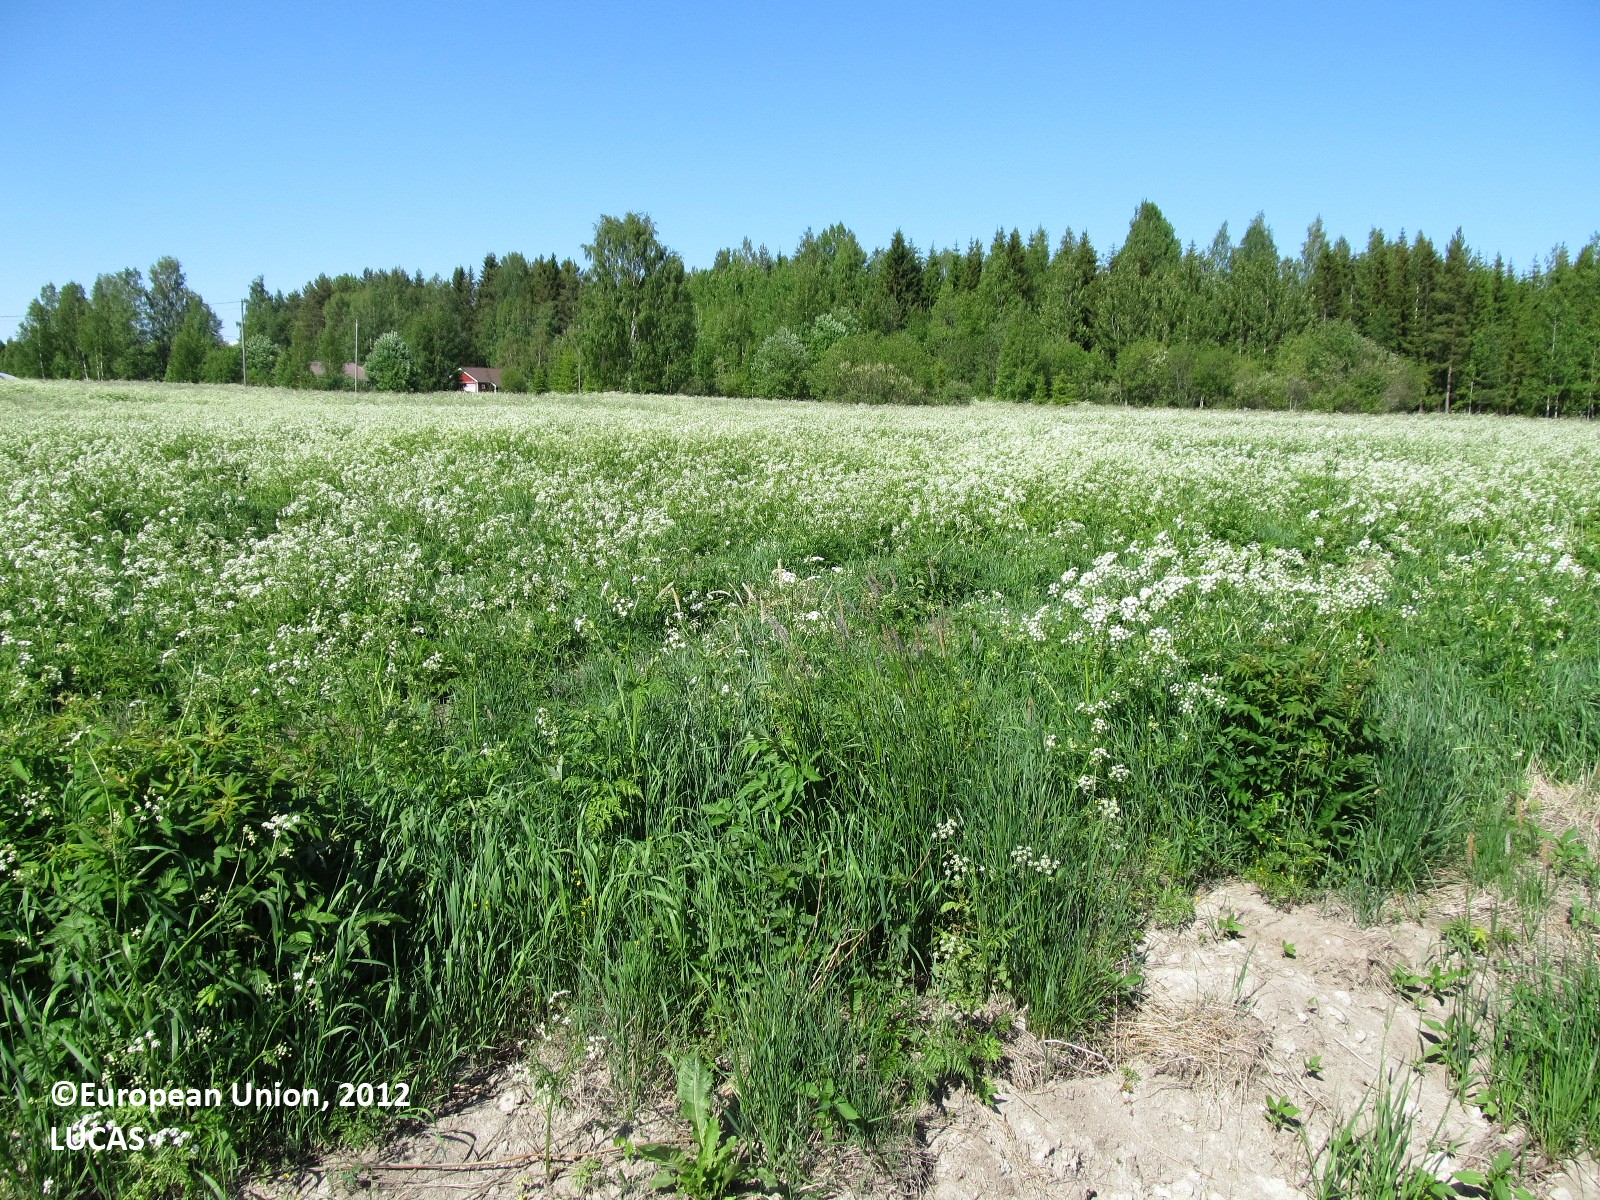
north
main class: Cropland
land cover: Barley
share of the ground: 25 - 50 %
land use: Agriculture (excluding fallow land and kitchen gardens)
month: June
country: FI
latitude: 63.0194
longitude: 27.5286
